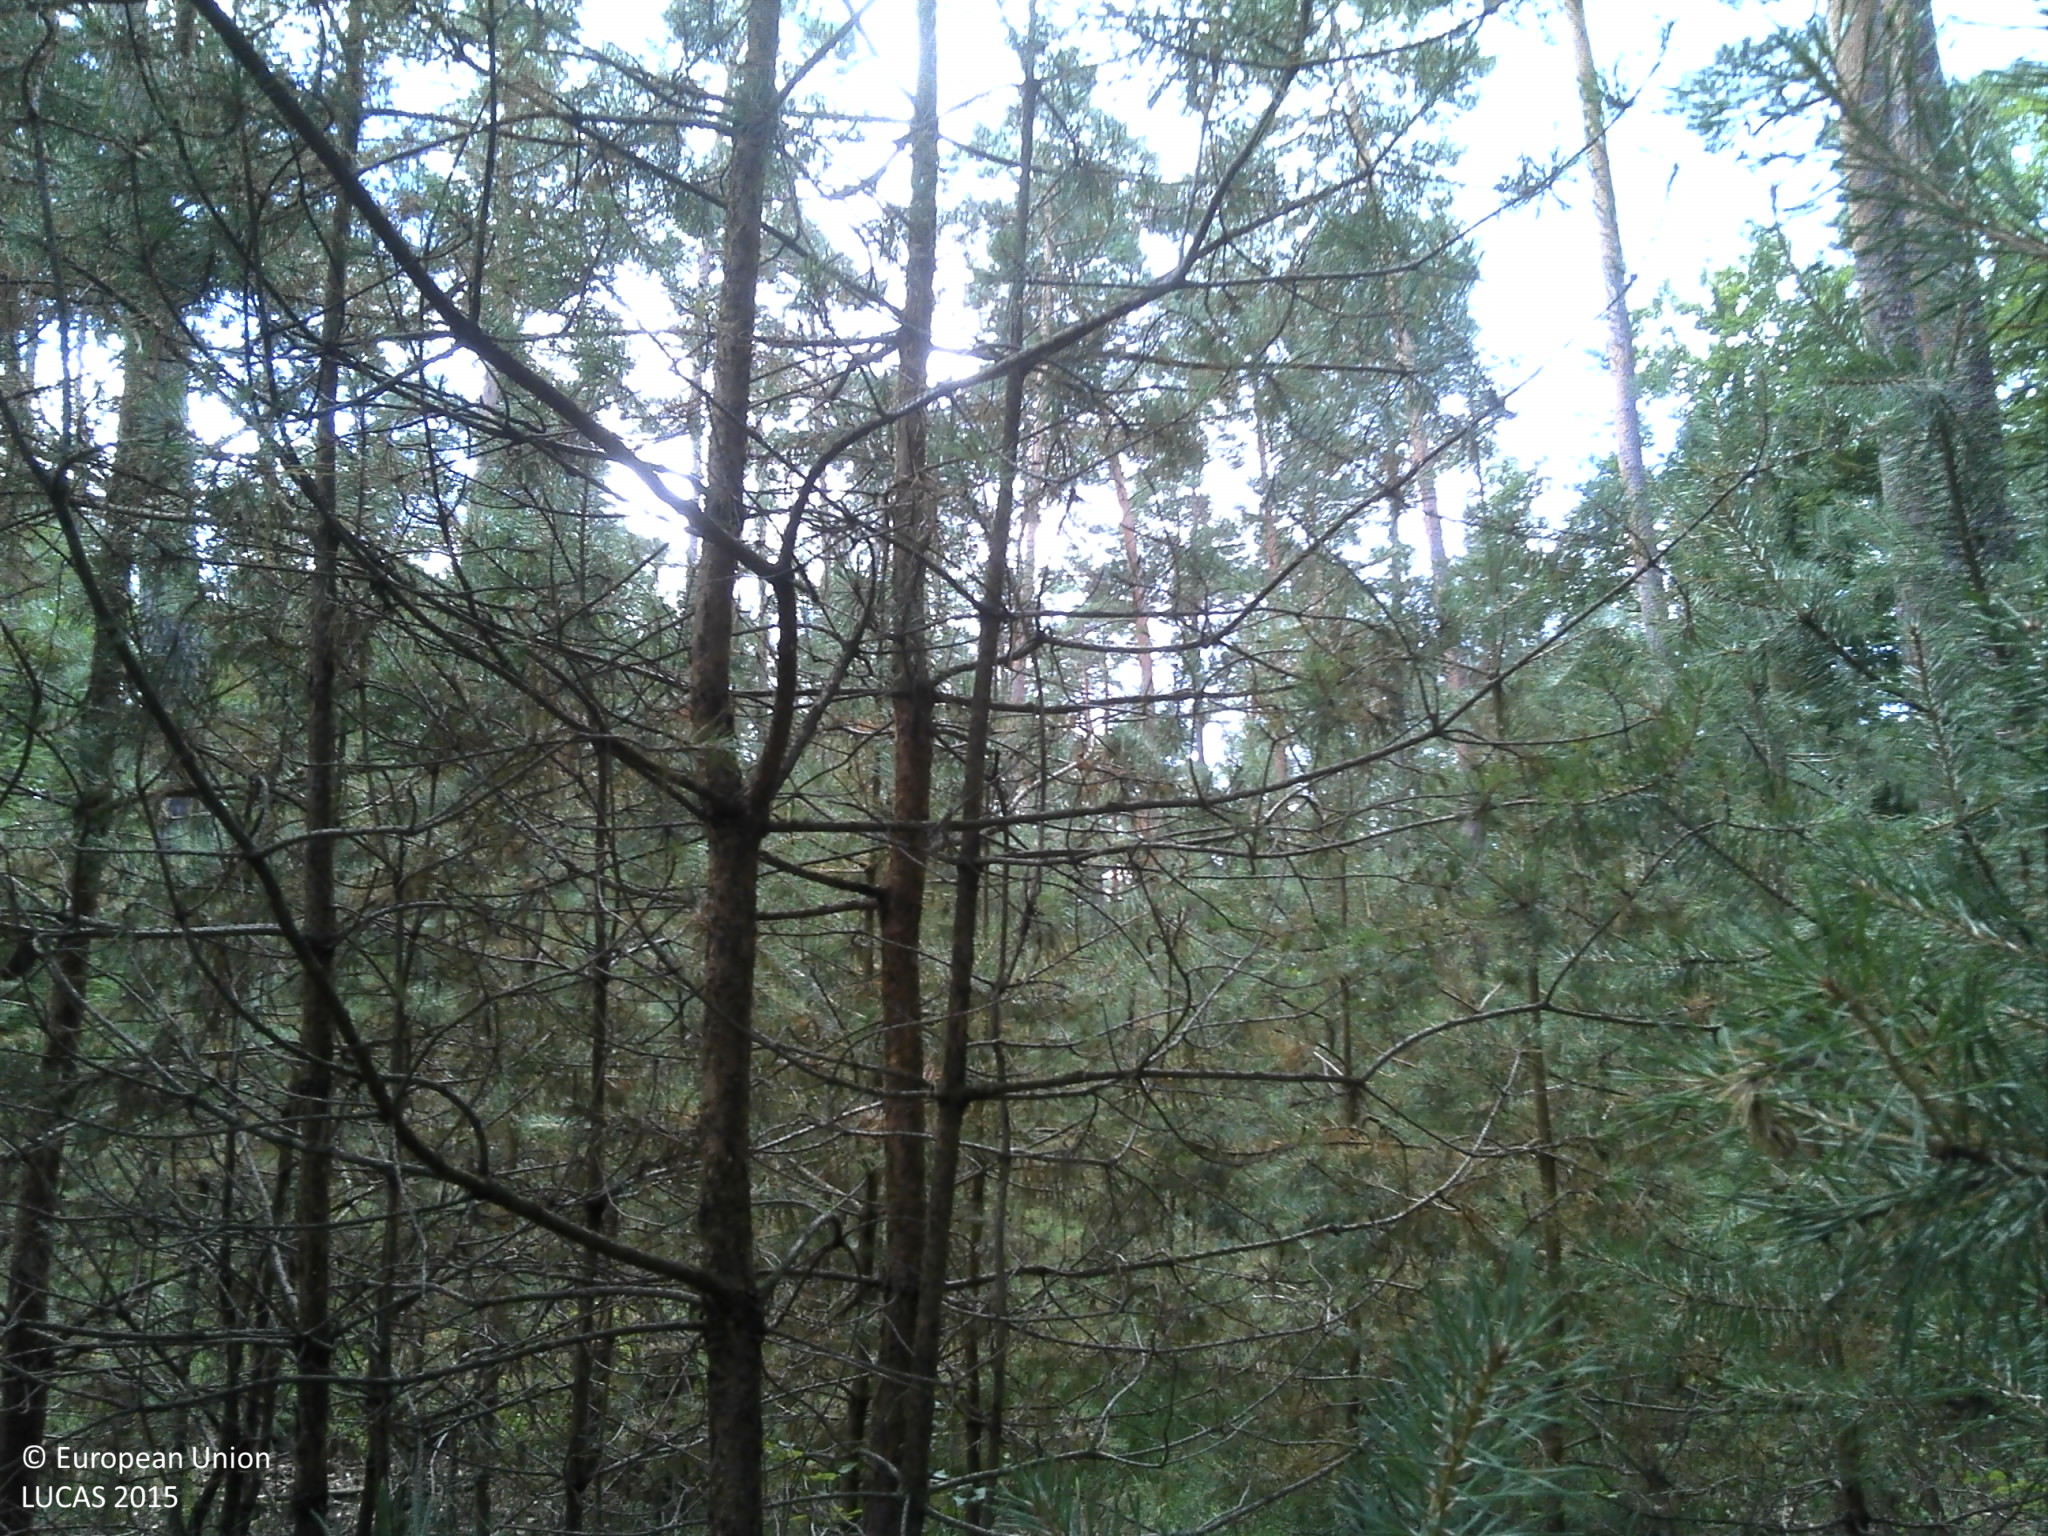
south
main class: Woodland
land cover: Pine dominated mixed woodland
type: hemiboreal forest and nemoral coniferous forest and mixed broadleaved-coniferous forest
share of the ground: > 75 %
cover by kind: coniferous forest trees 40 %, broadleaved forest trees 40 %, unconsolidated bare surface 10 %, herbaceous plants 5 %, lichens and mosses 5 %
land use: Forestry
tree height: > 5 m
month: July
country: FR
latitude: 49.0441
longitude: 7.6338
